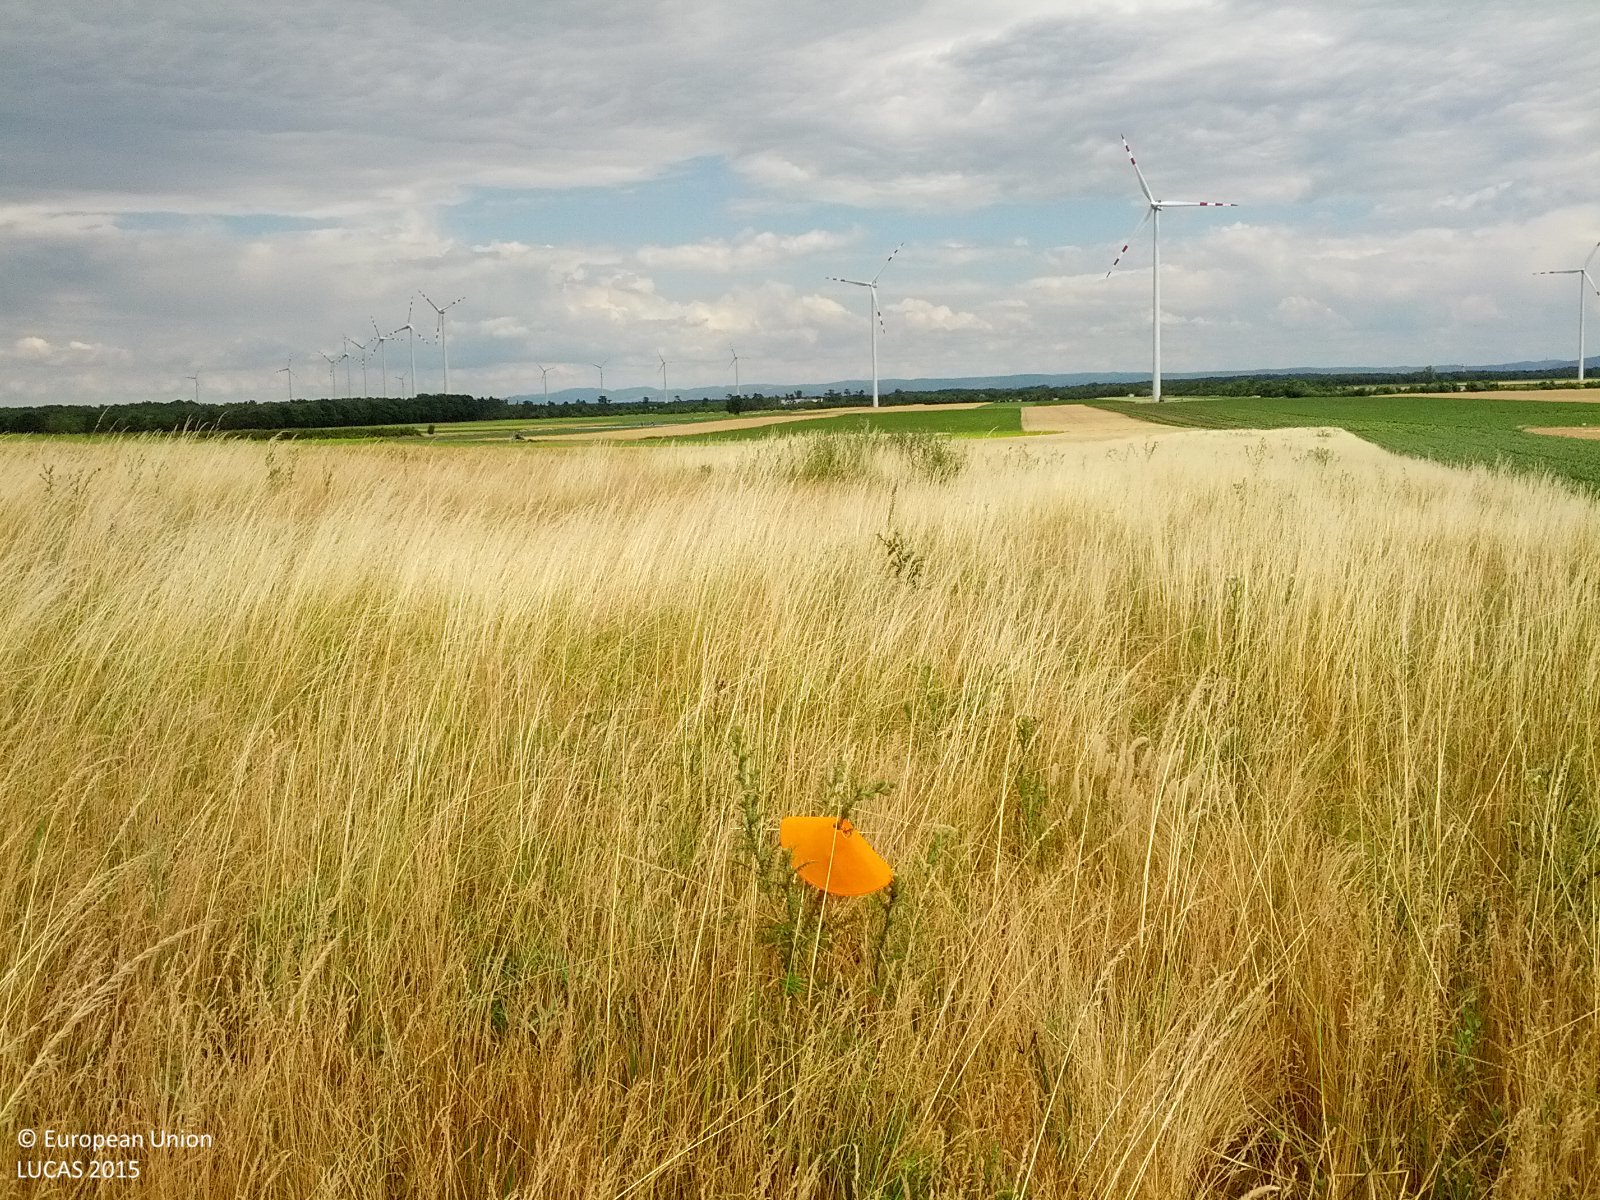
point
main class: Grassland
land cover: Grassland without tree/shrub cover
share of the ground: > 75 %
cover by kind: herbaceous plants 100 %
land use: Agriculture (excluding fallow land and kitchen gardens)
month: June
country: AT
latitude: 48.2755
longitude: 16.6490
